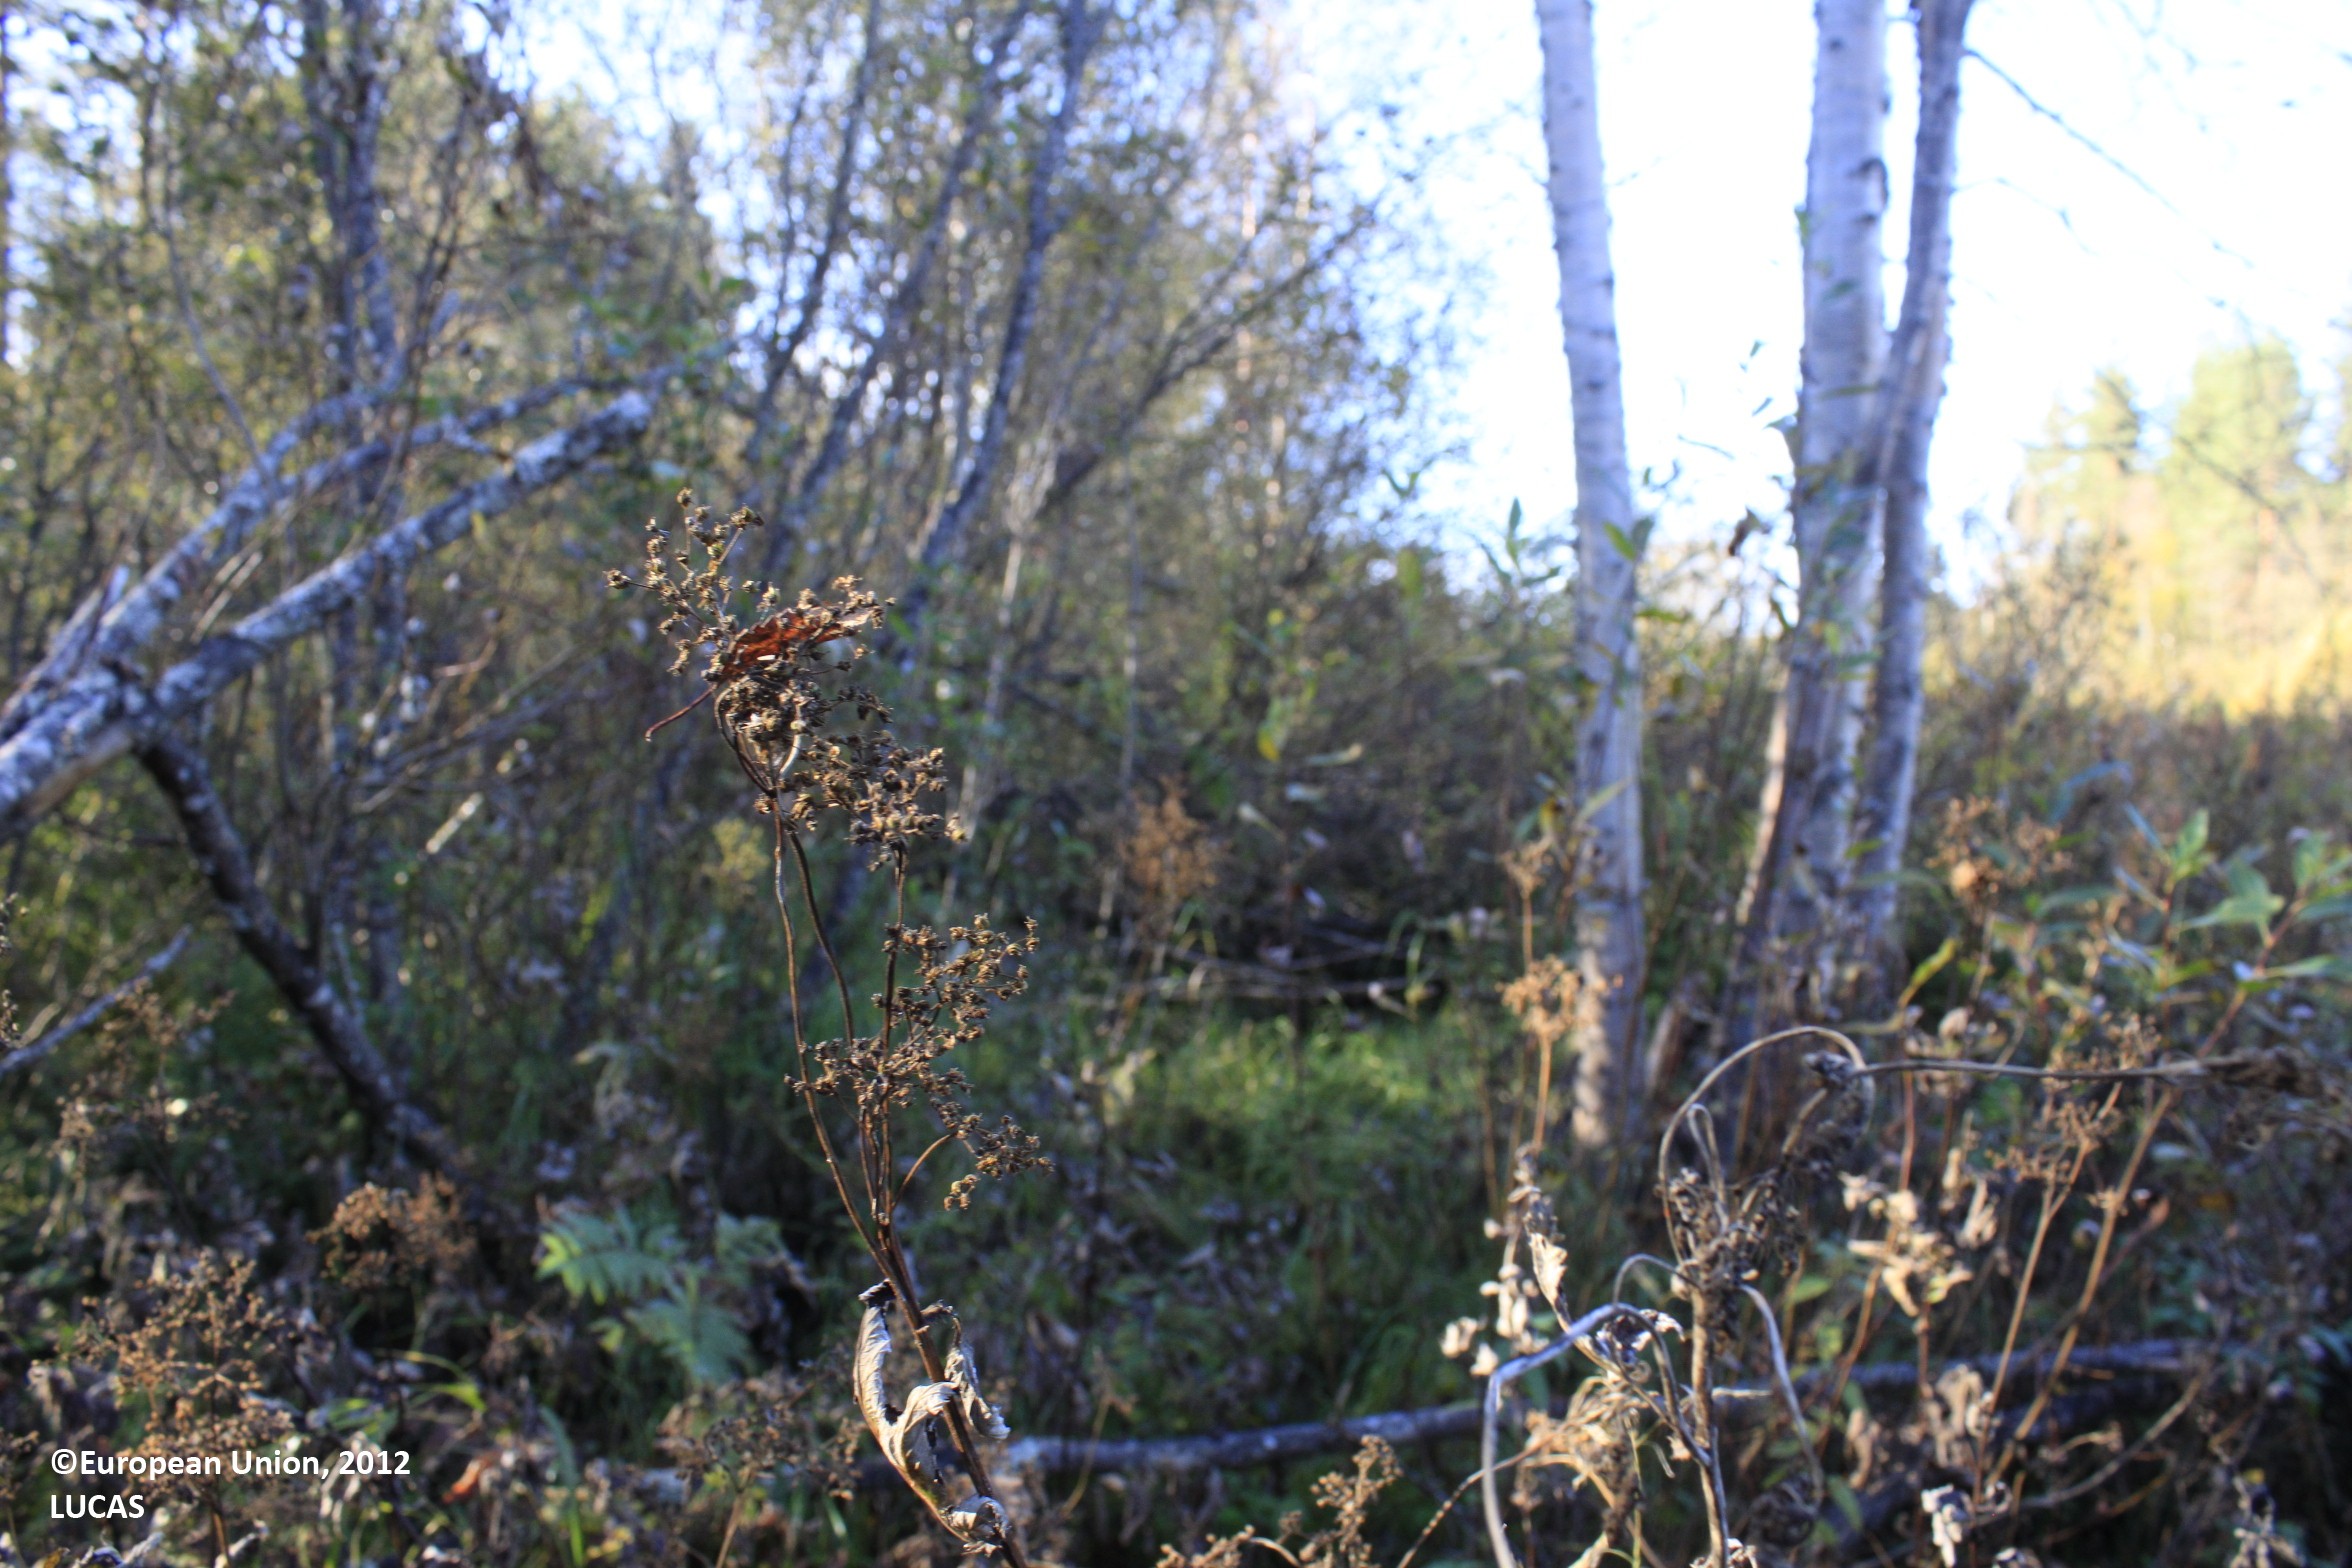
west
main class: Woodland
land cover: Pine dominated mixed woodland
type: boreal forest
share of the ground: 50 - 75 %
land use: Forestry
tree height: > 5 m
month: September
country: FI
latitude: 63.7030
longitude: 25.8683
